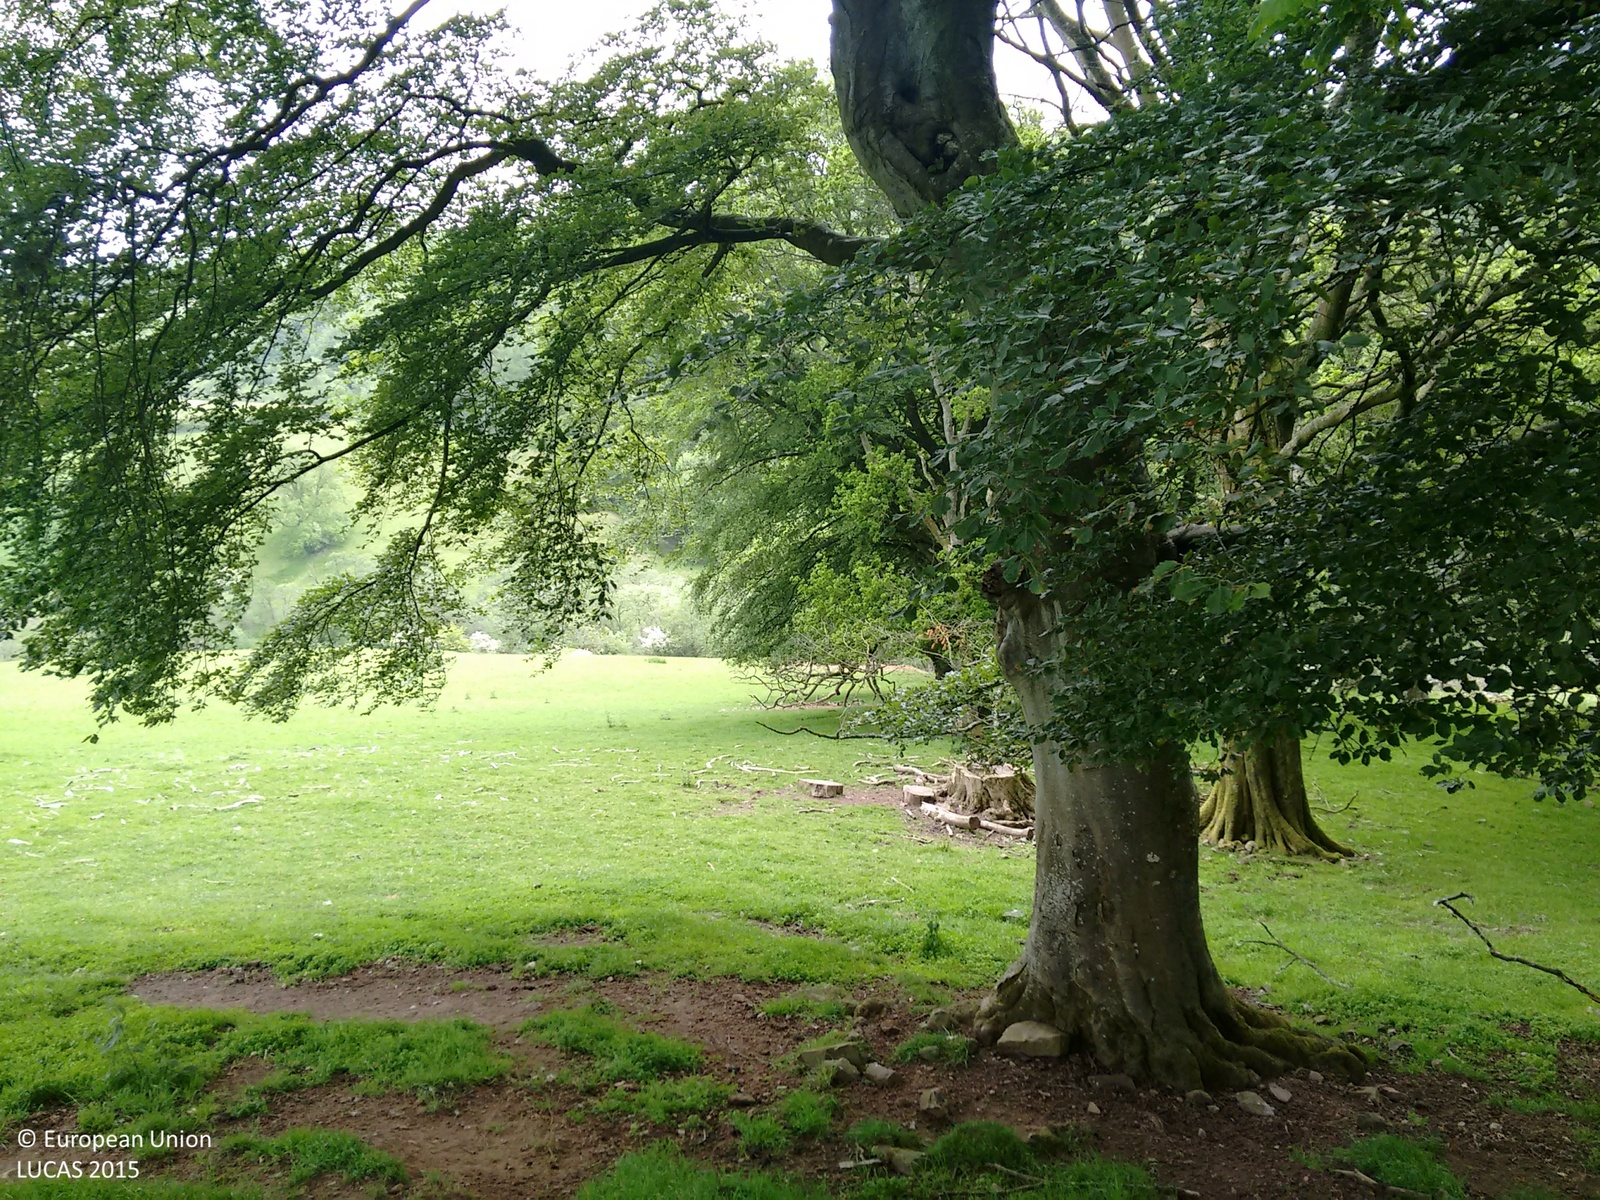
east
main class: Woodland
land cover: Broadleaved woodland
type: mesophytic deciduous forest
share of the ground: > 75 %
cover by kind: broadleaved forest trees 80 %, herbaceous plants 20 %
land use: Agriculture (excluding fallow land and kitchen gardens)
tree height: > 5 m
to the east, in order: Broadleaved woodland; Grassland without tree/shrub cover; Rocks and stones; Broadleaved woodland; Grass margins; Fences; Grass margins; Dry stone walls; Broadleaved woodland; Rivers and streams; Broadleaved woodland; Fences; Grassland without tree/shrub cover
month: June
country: GB
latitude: 55.1921
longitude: -3.7031
